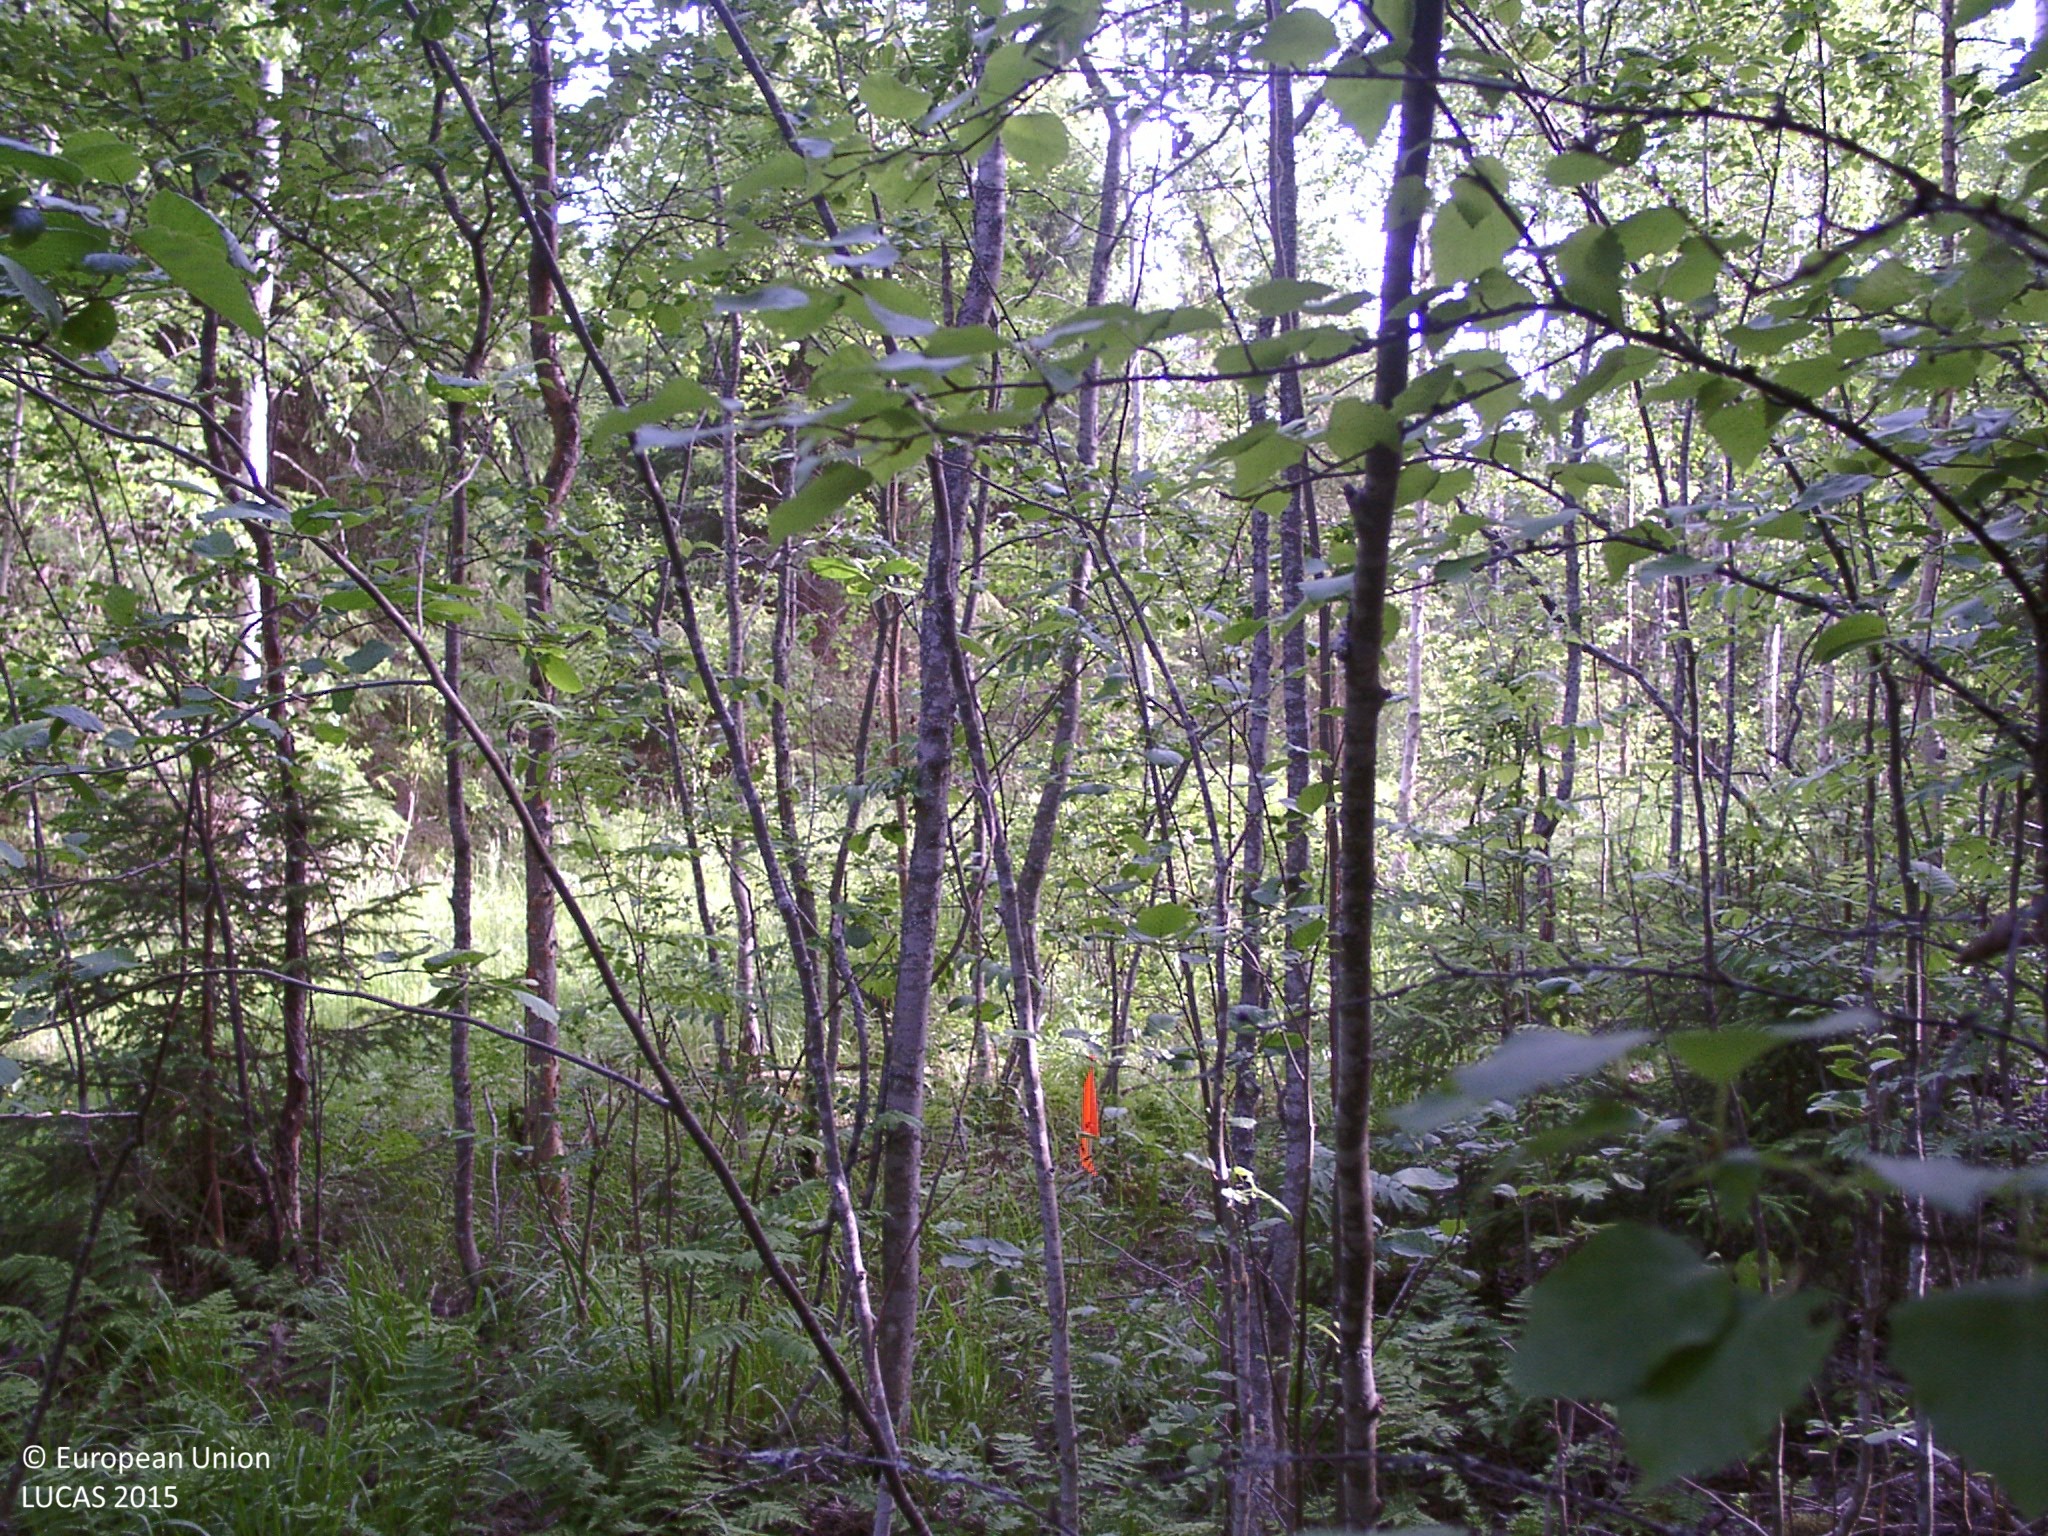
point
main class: Woodland
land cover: Broadleaved woodland
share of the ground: 50 - 75 %
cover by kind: broadleaved forest trees 60 %, herbaceous plants 25 %, coniferous forest trees 10 %, unconsolidated bare surface 5 %
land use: Semi-natural and natural areas not in use
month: June
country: FI
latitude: 62.0528
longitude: 25.0435
